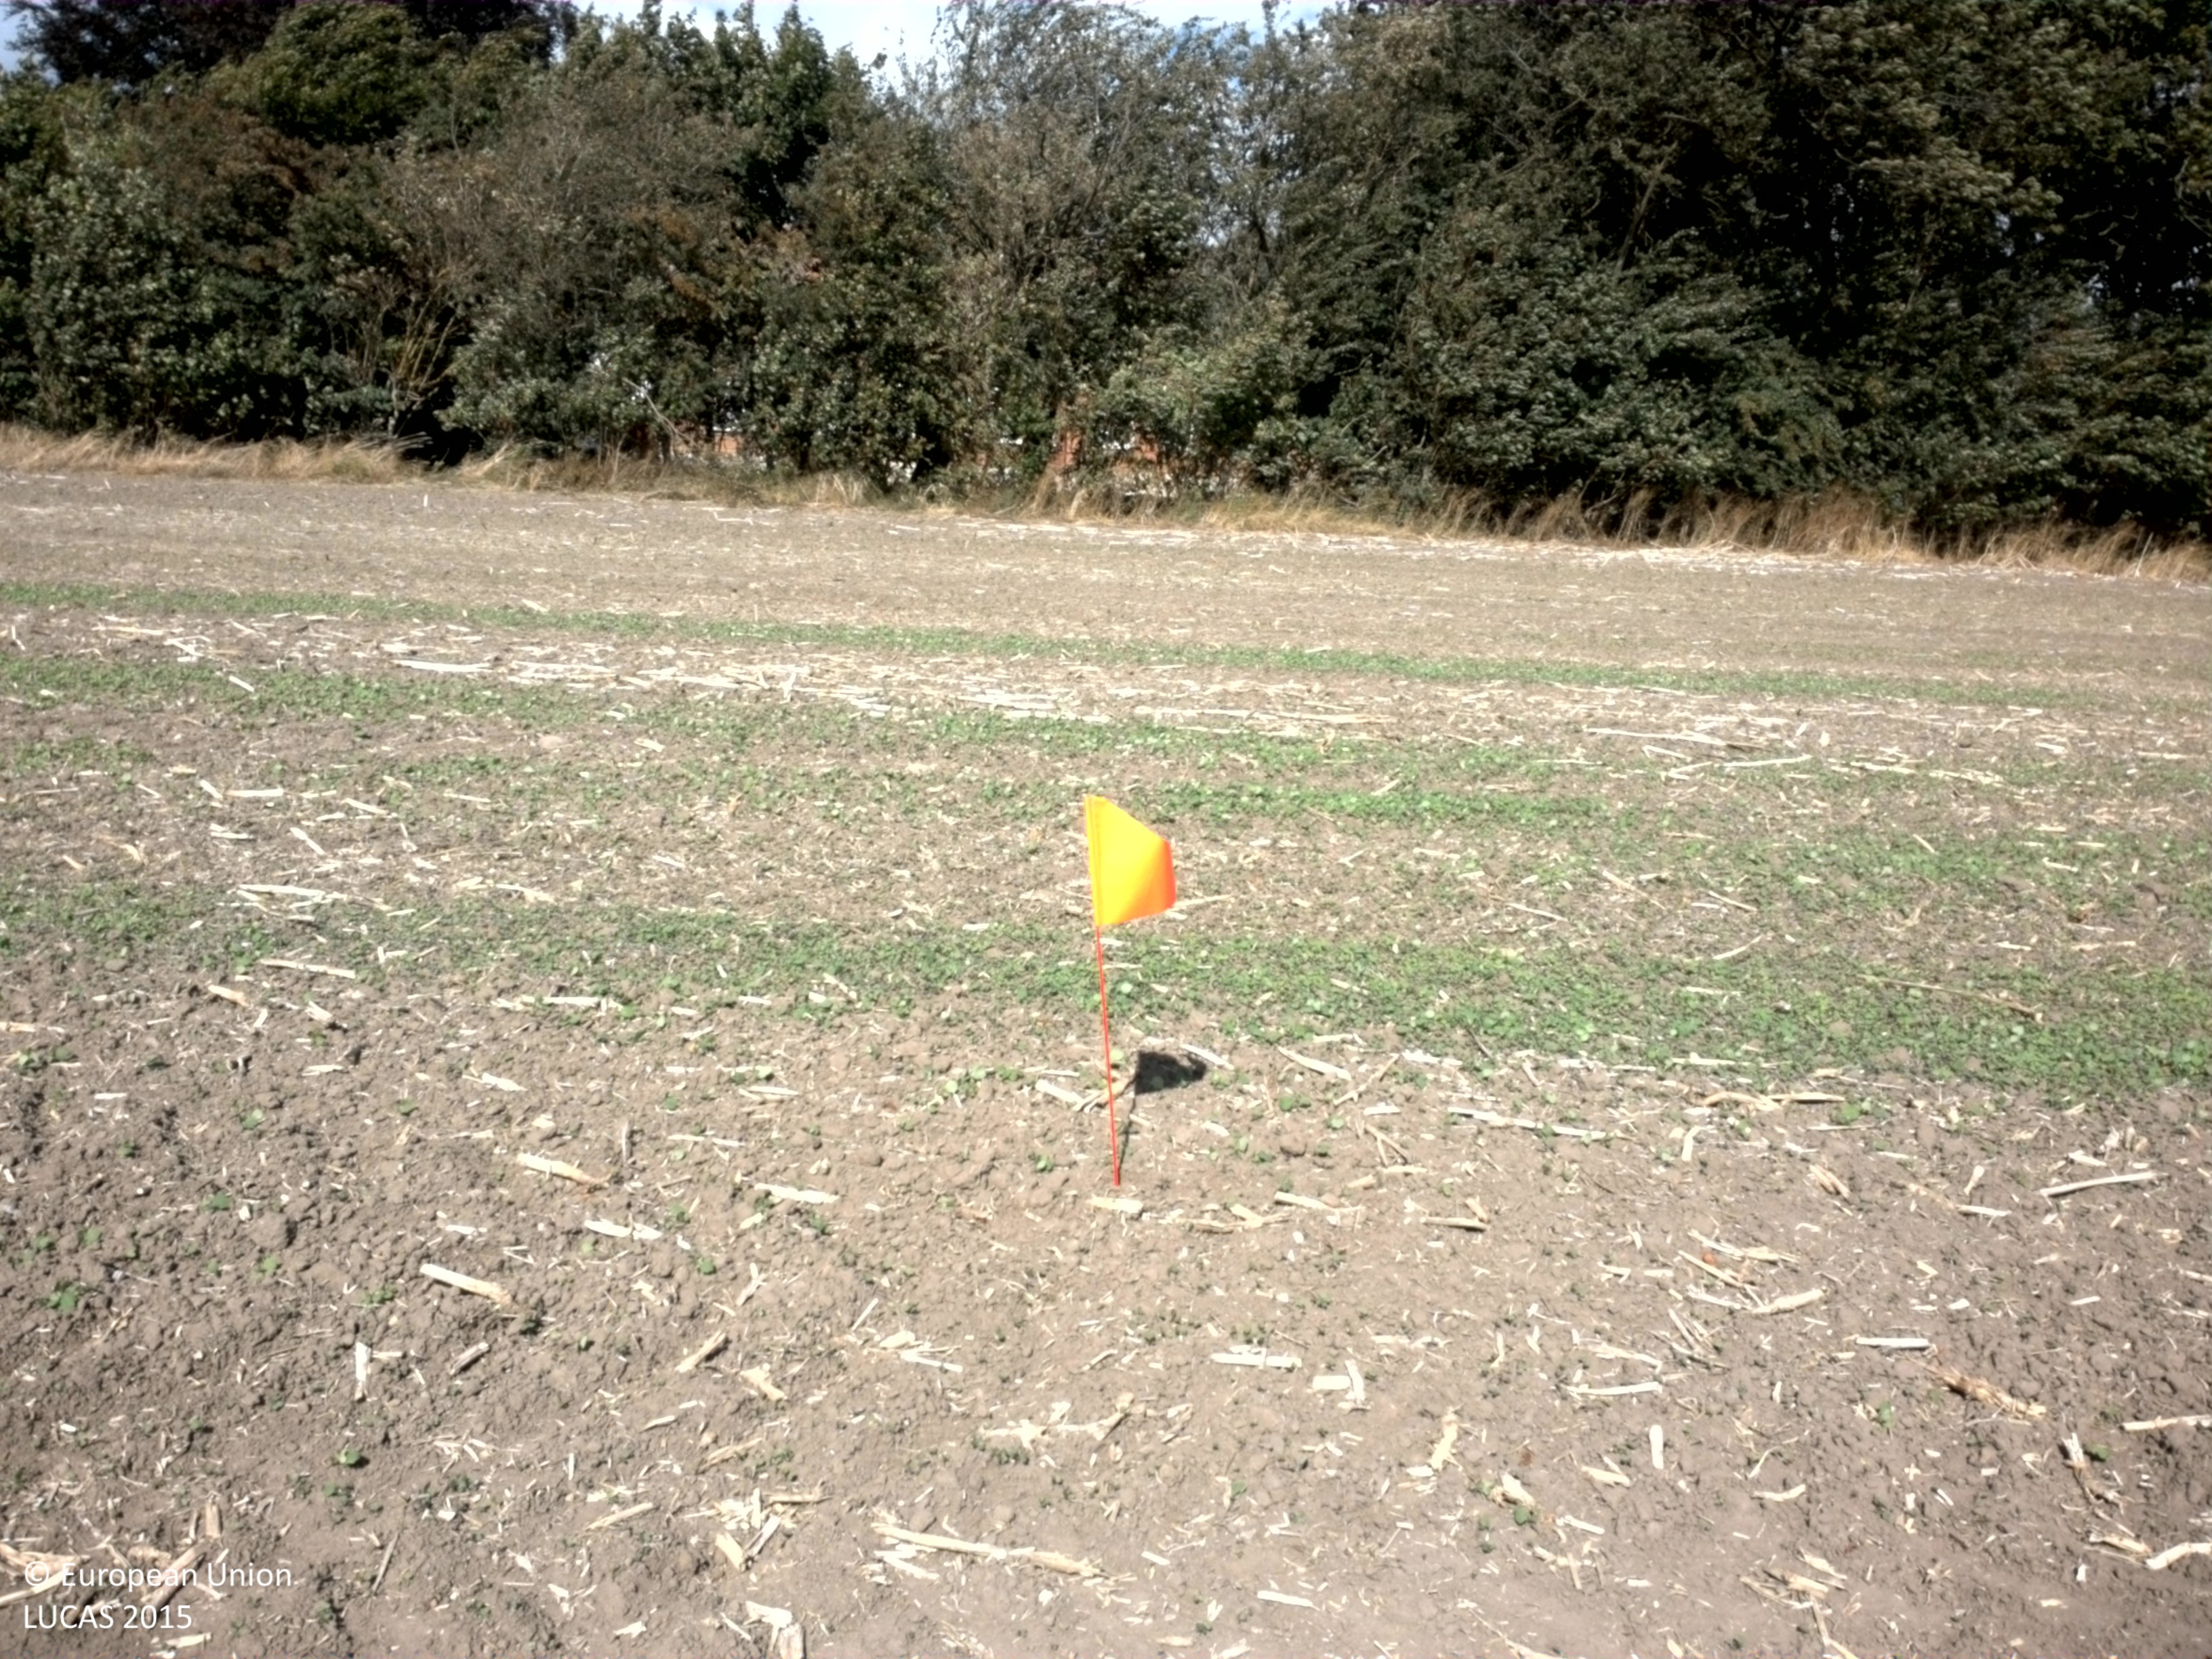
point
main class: Cropland
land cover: Rape and turnip rape
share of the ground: < 10 %
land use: Agriculture (excluding fallow land and kitchen gardens)
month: September
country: SE
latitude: 55.4893
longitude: 14.1927
